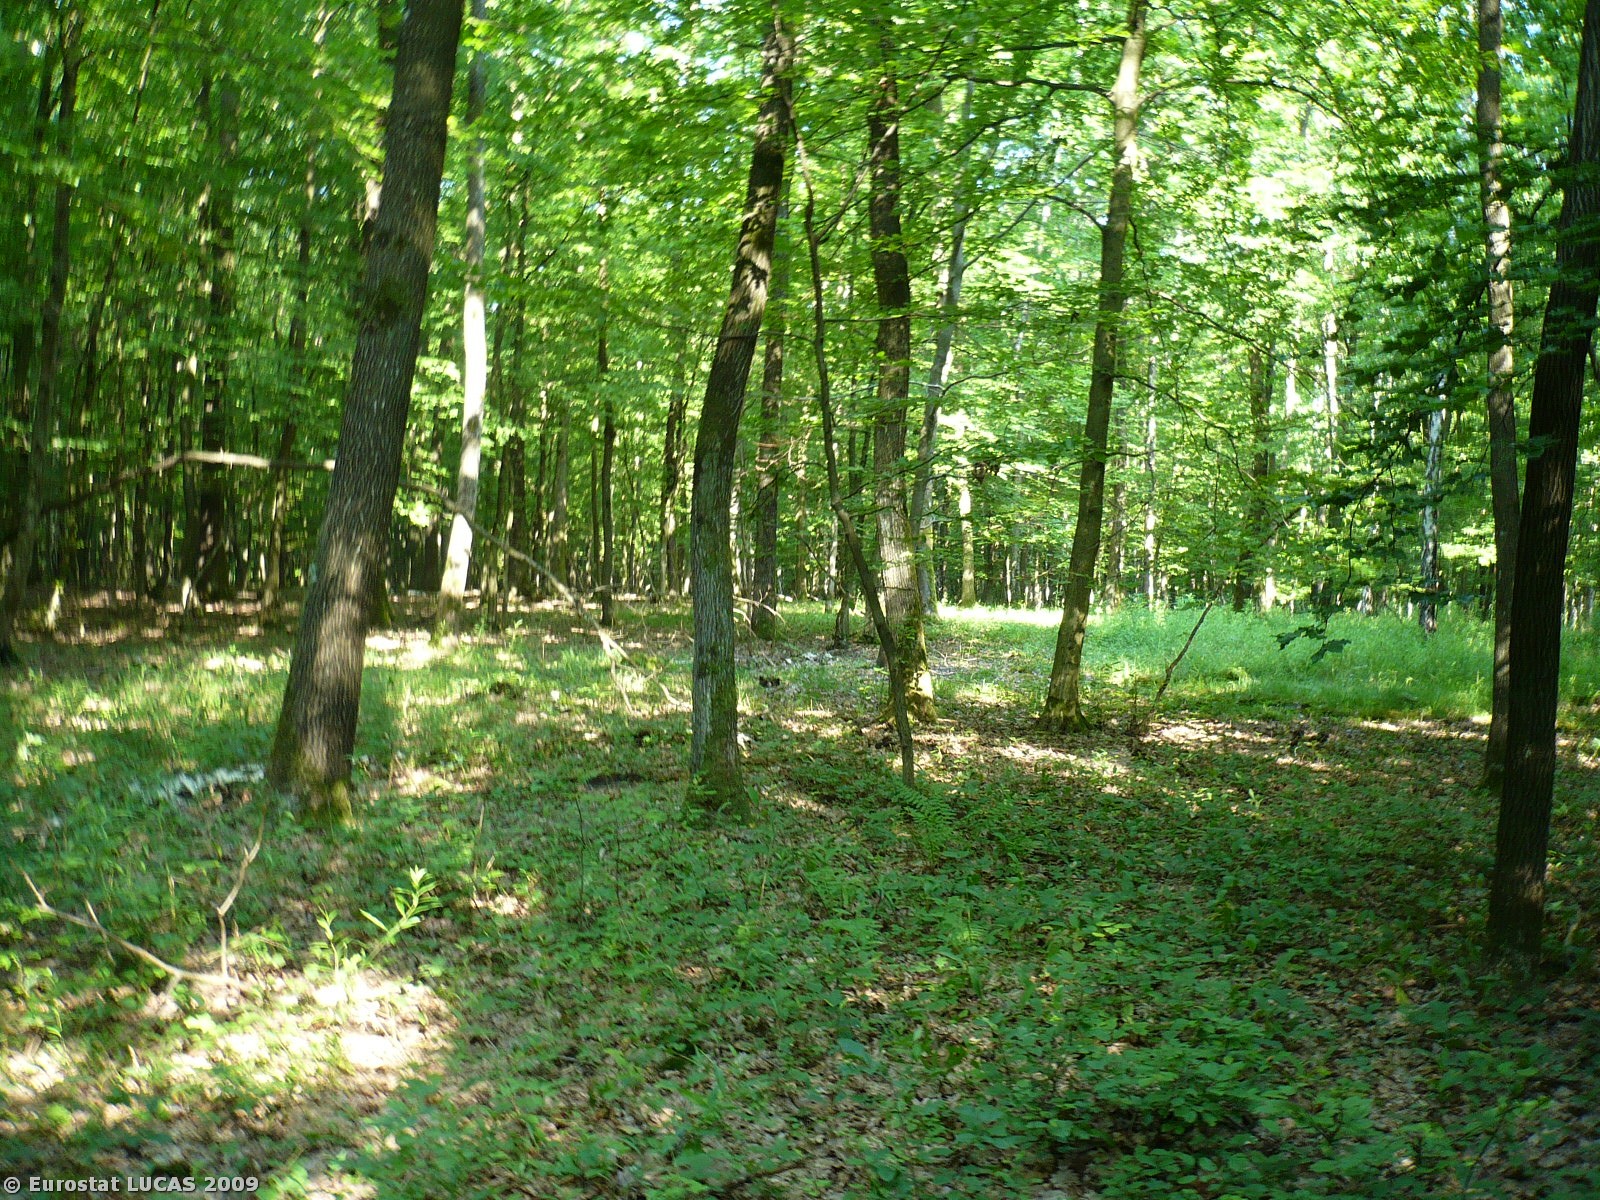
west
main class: Woodland
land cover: Broadleaved woodland
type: mesophytic deciduous forest
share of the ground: > 75 %
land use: Forestry
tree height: > 5 m
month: July
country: SI
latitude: 46.6852
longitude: 16.3686
